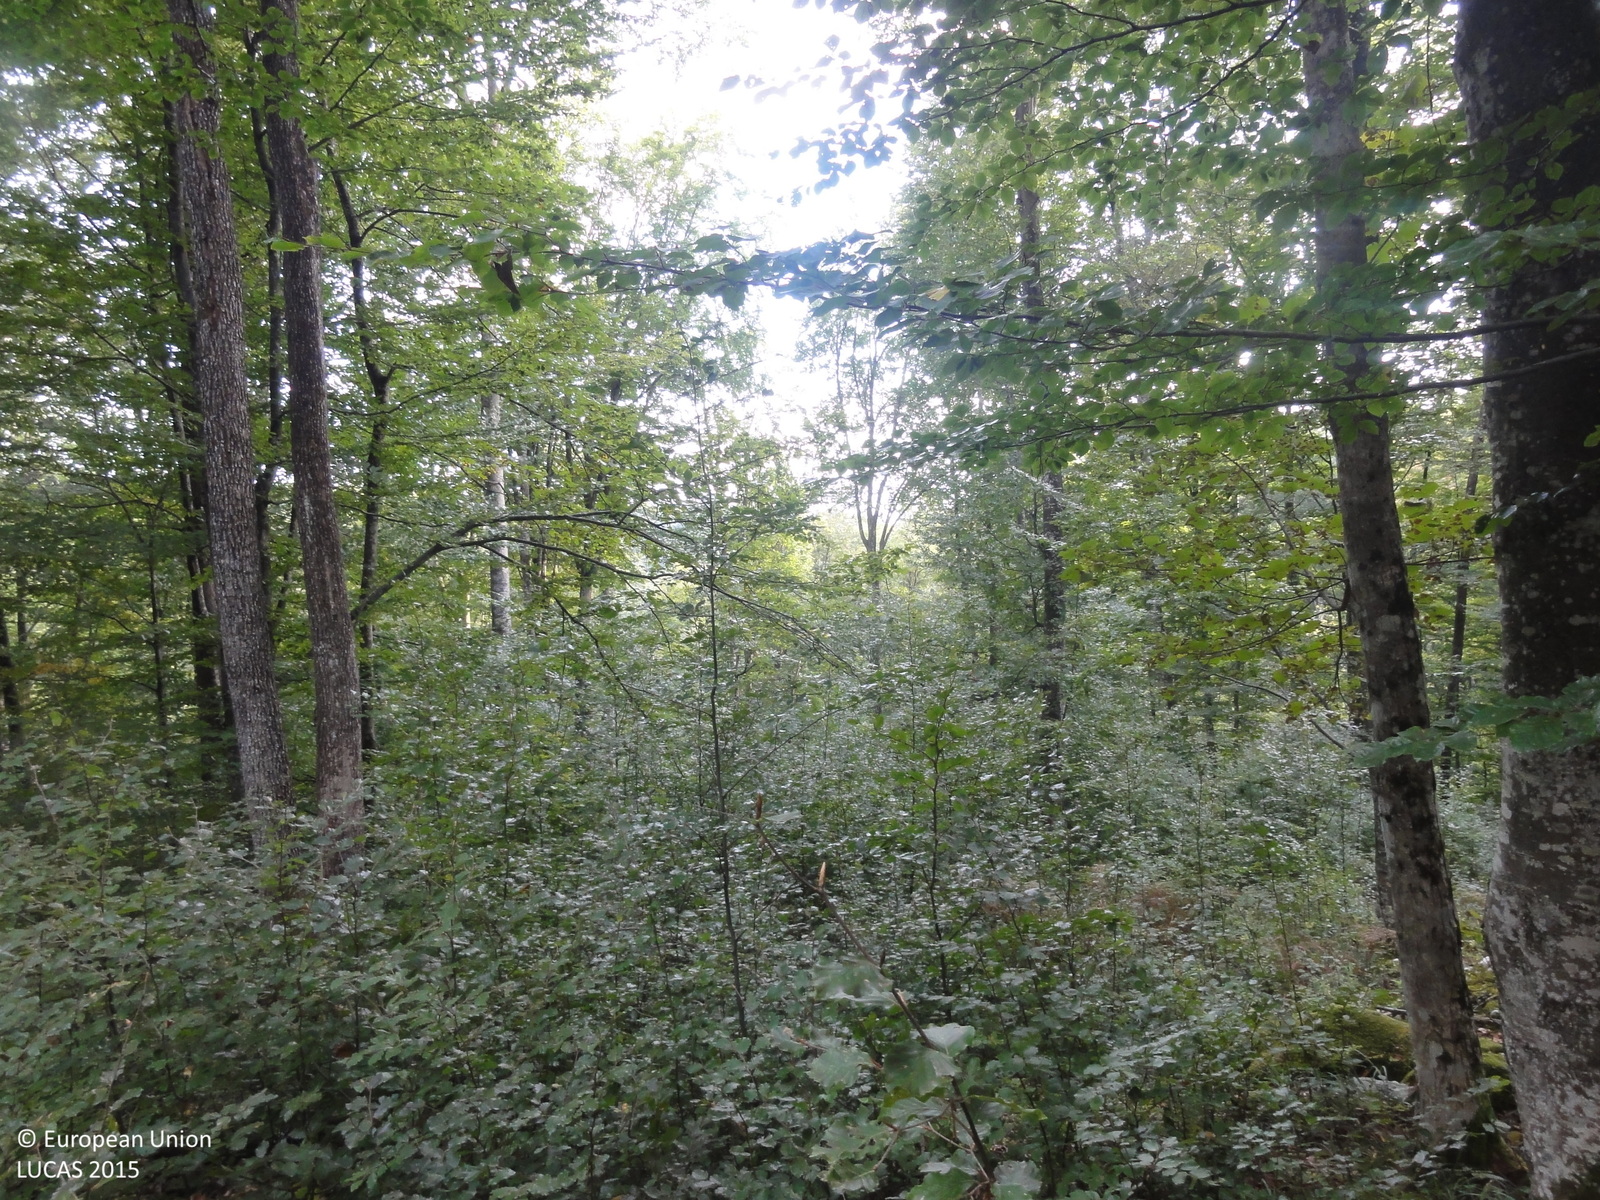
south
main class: Woodland
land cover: Broadleaved woodland
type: beech forest
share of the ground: > 75 %
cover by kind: broadleaved forest trees 90 %, shrubs 10 %
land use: Forestry
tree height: > 5 m
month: September
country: SI
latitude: 45.5662
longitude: 15.0056
